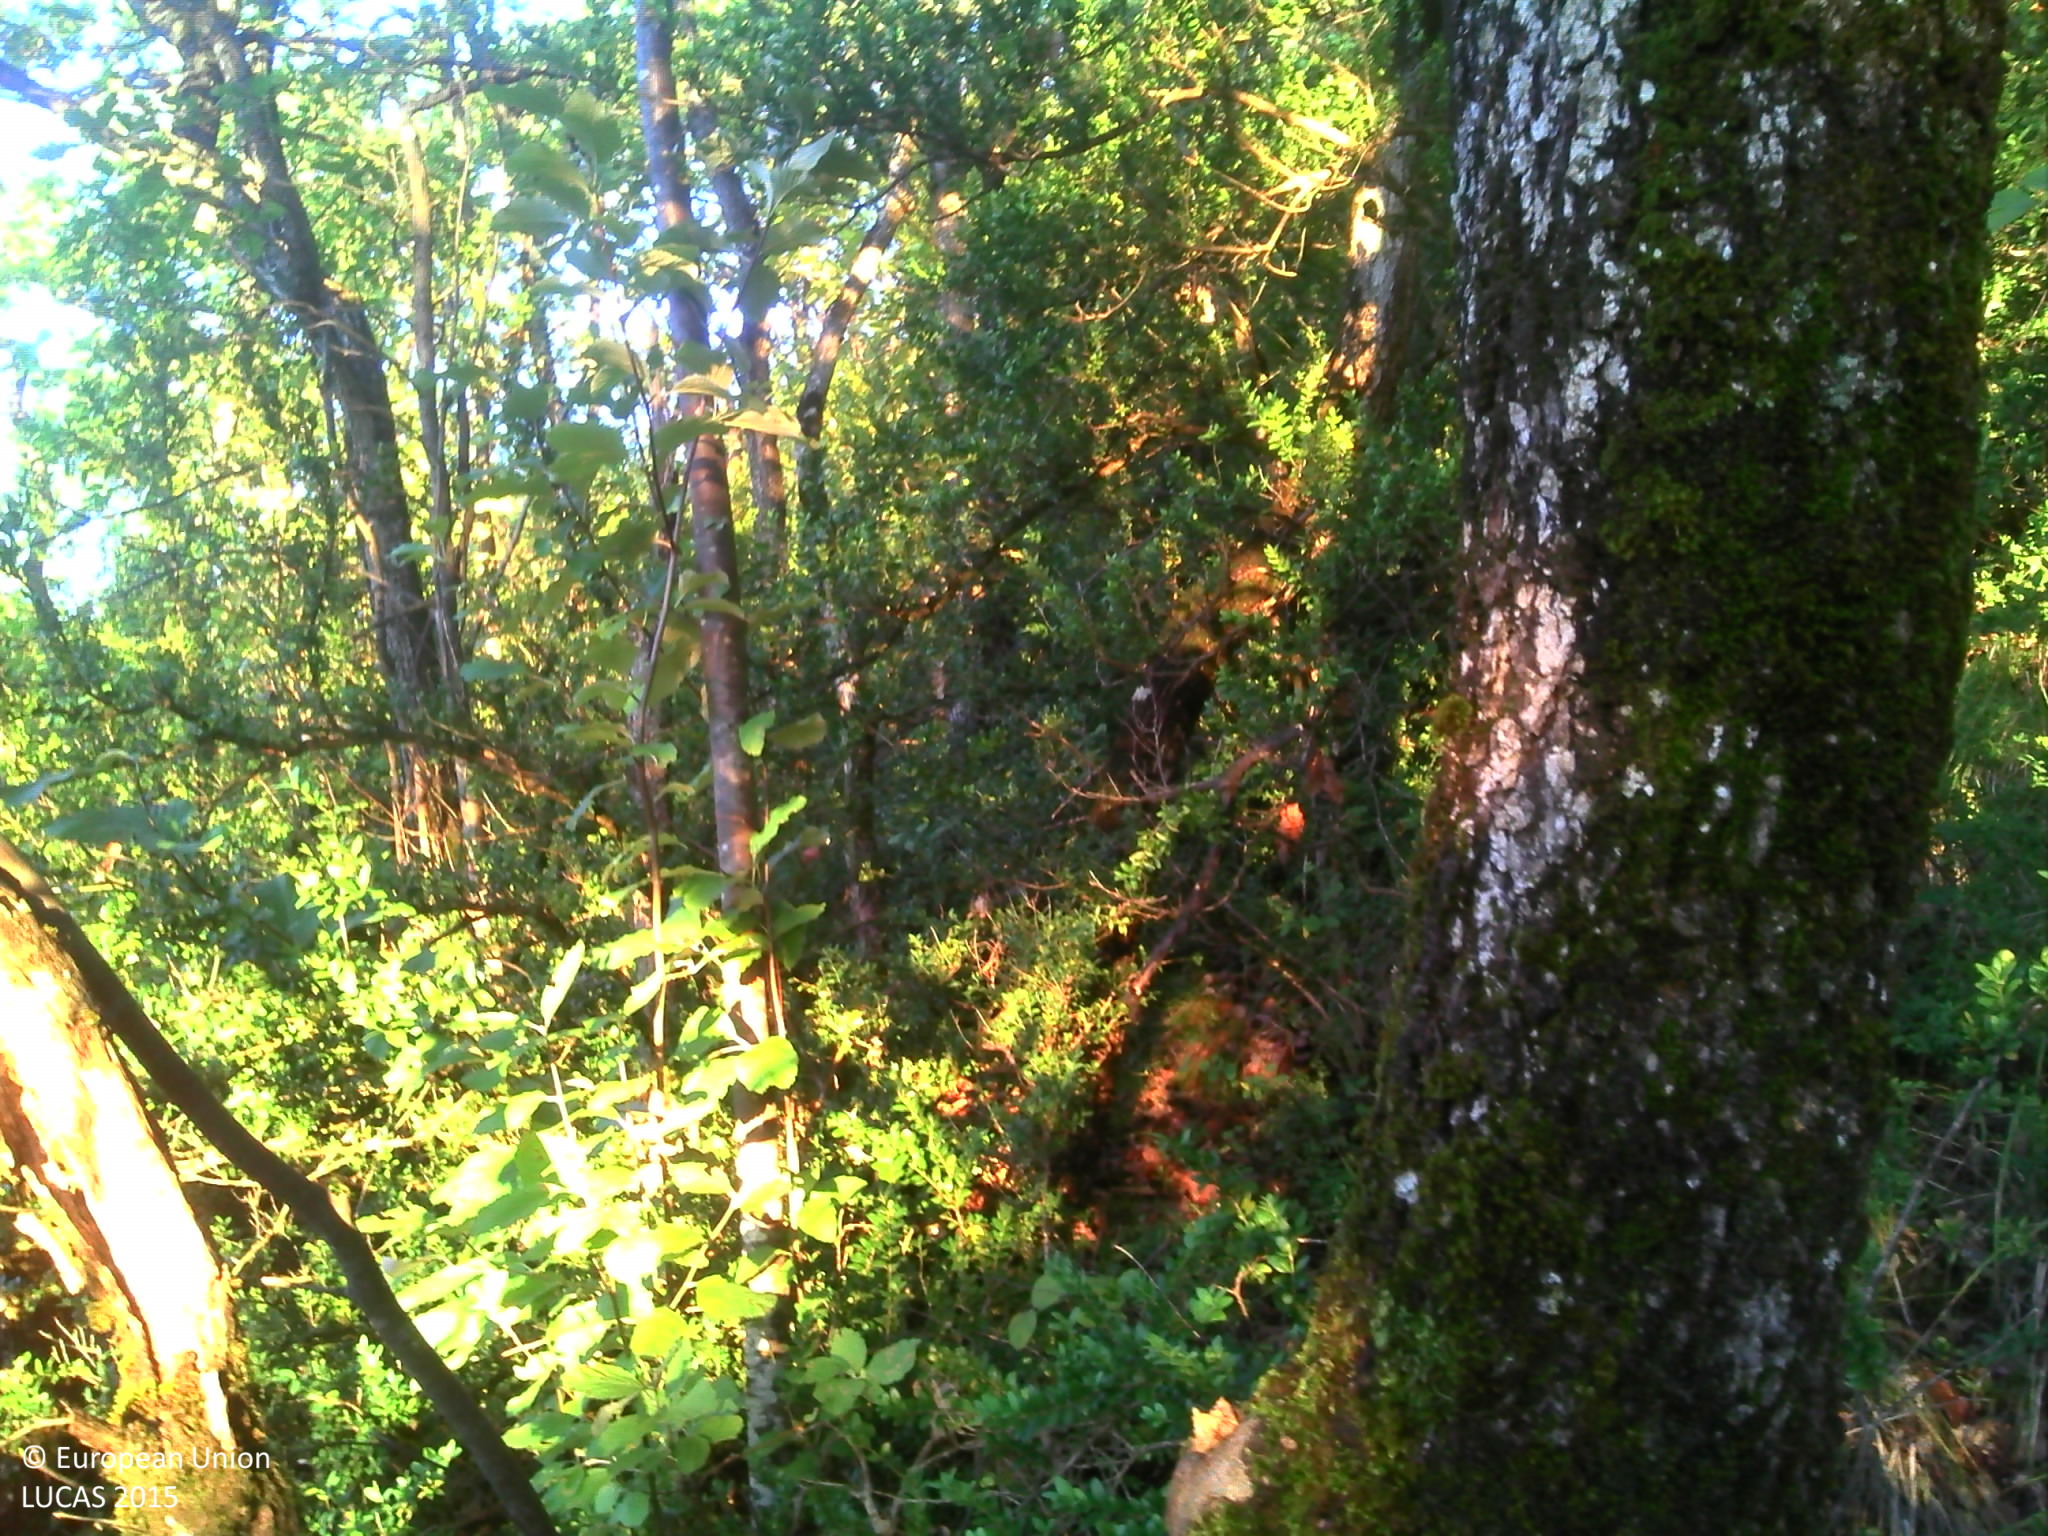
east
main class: Woodland
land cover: Broadleaved woodland
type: mesophytic deciduous forest
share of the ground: > 75 %
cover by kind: broadleaved forest trees 85 %, coniferous forest trees 5 %, shrubs 5 %, lichens and mosses 5 %
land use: Semi-natural and natural areas not in use
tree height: > 5 m
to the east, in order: Broadleaved woodland; Pine dominated mixed woodland
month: September
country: FR
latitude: 44.3457
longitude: 5.1529
